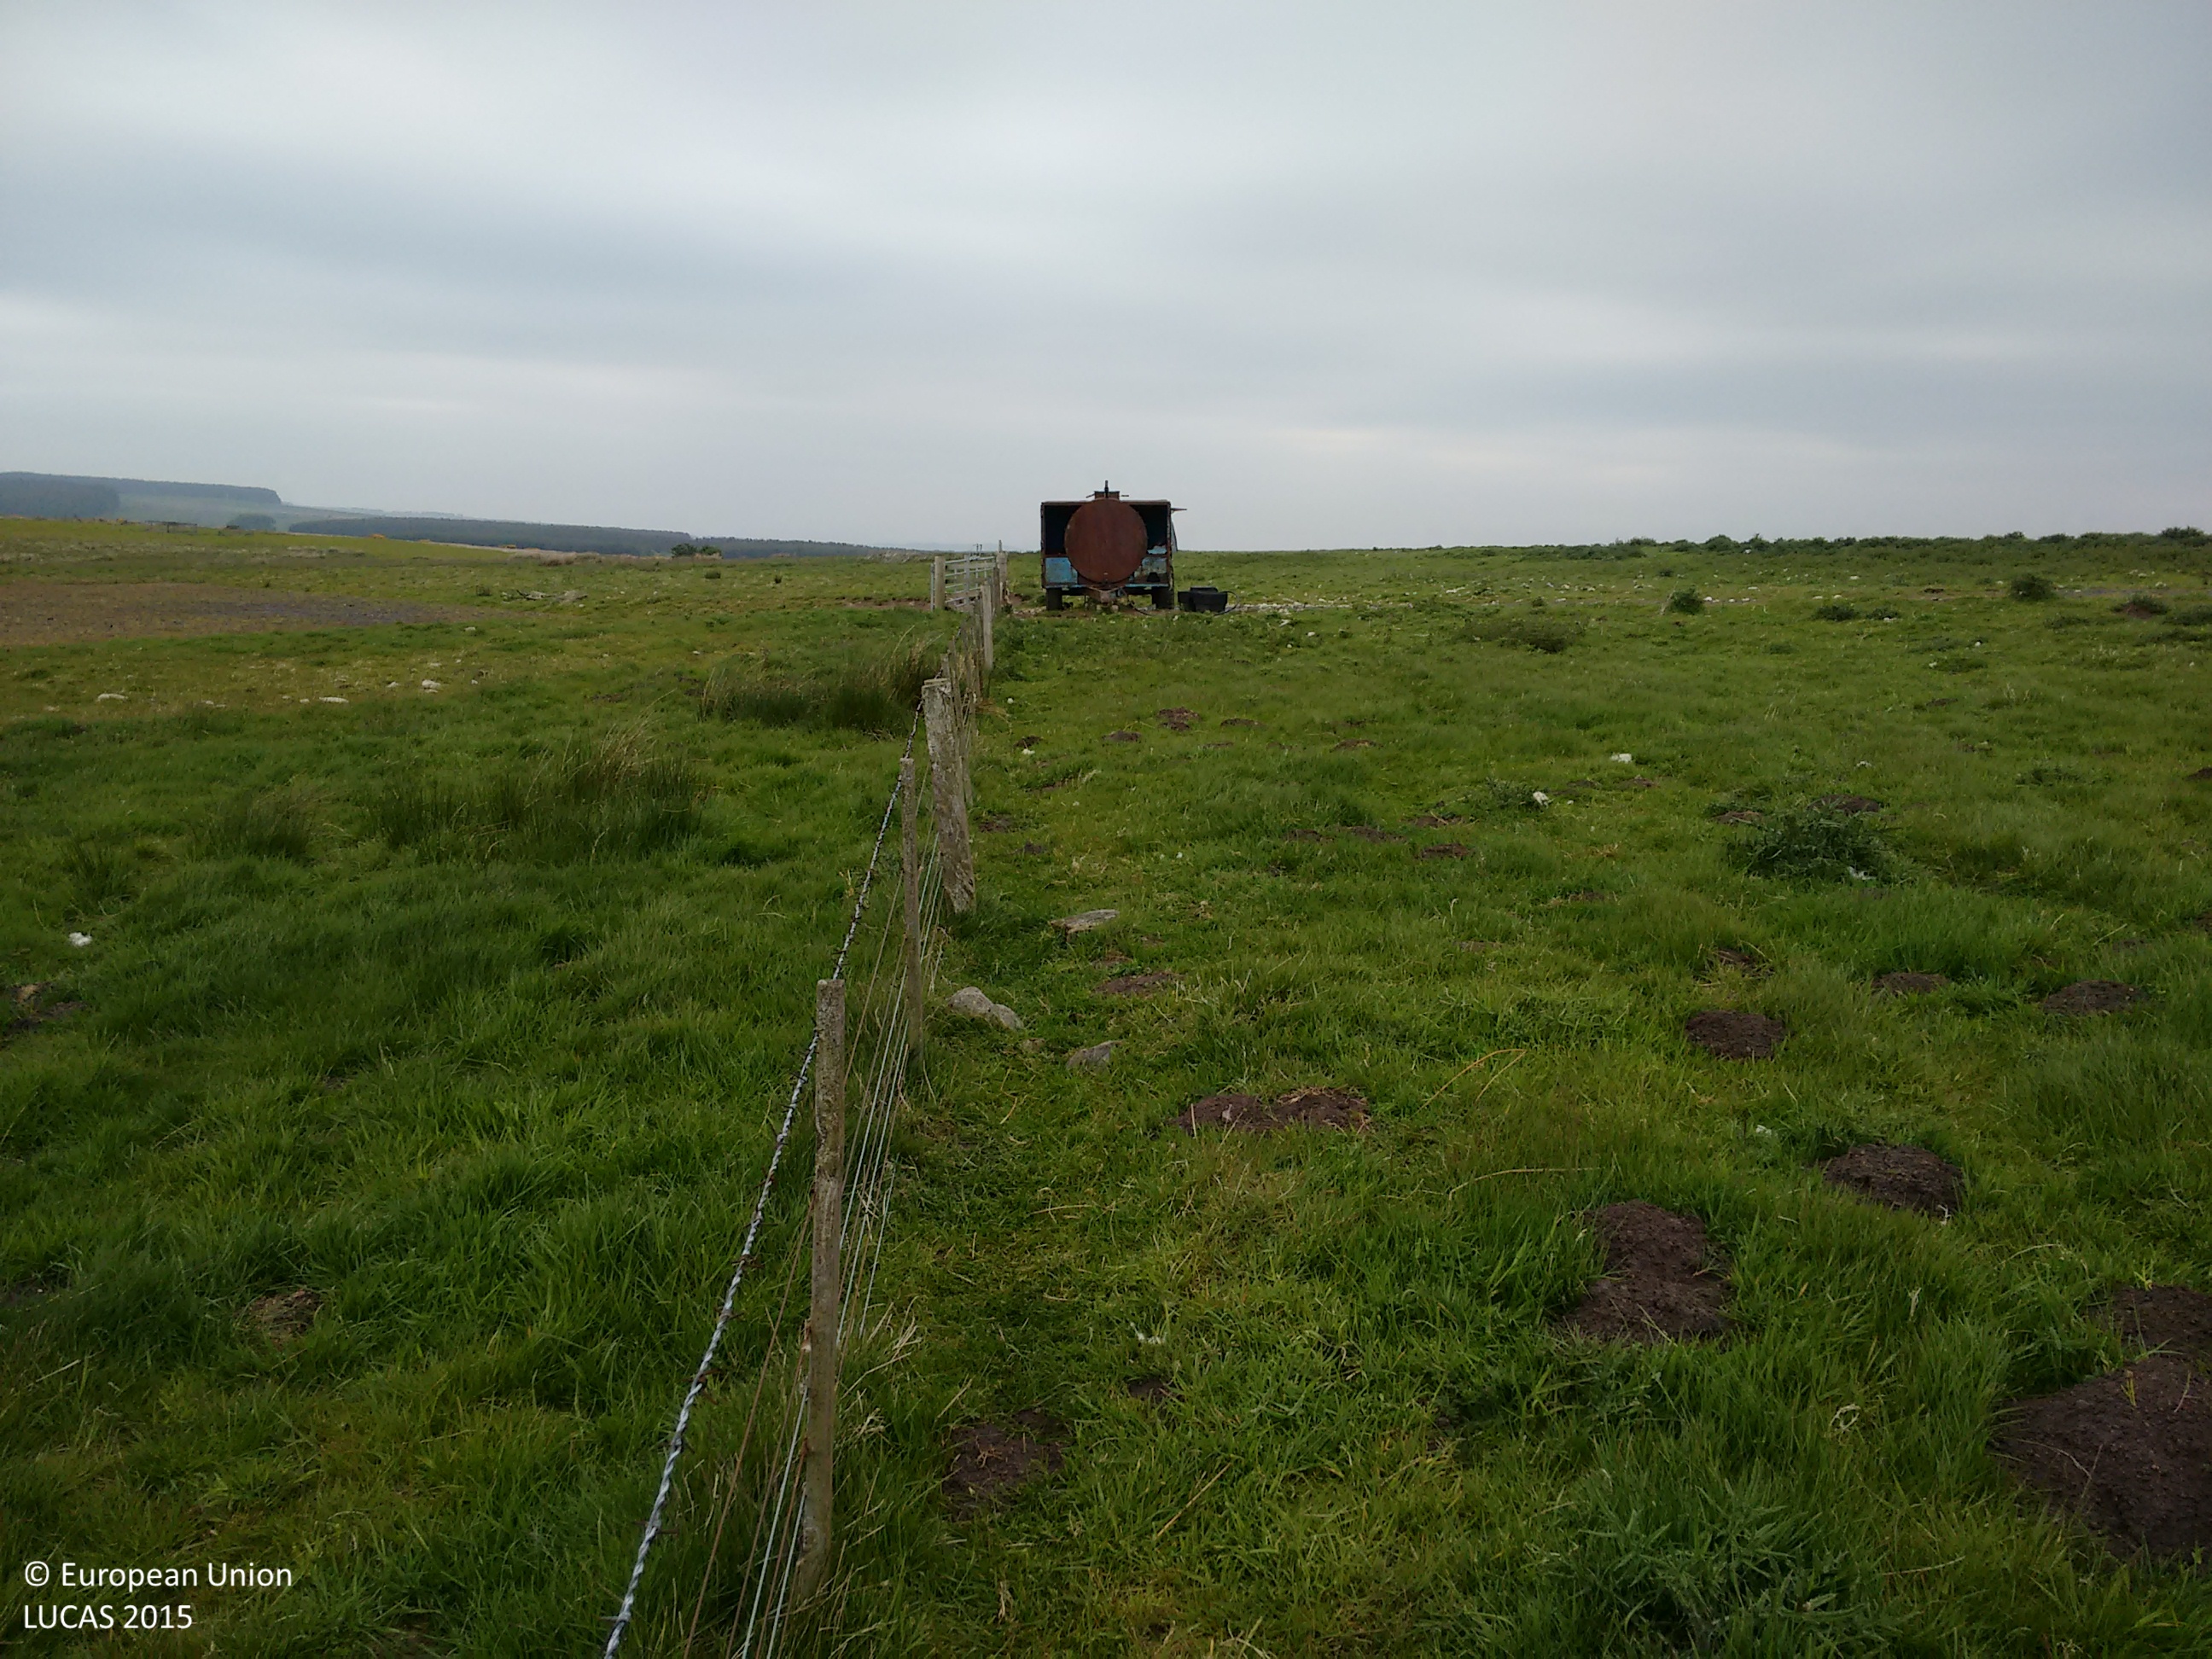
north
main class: Grassland
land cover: Grassland without tree/shrub cover
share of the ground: > 75 %
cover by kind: herbaceous plants 100 %
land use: Agriculture (excluding fallow land and kitchen gardens)
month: June
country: GB
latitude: 55.5152
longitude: -1.7849
